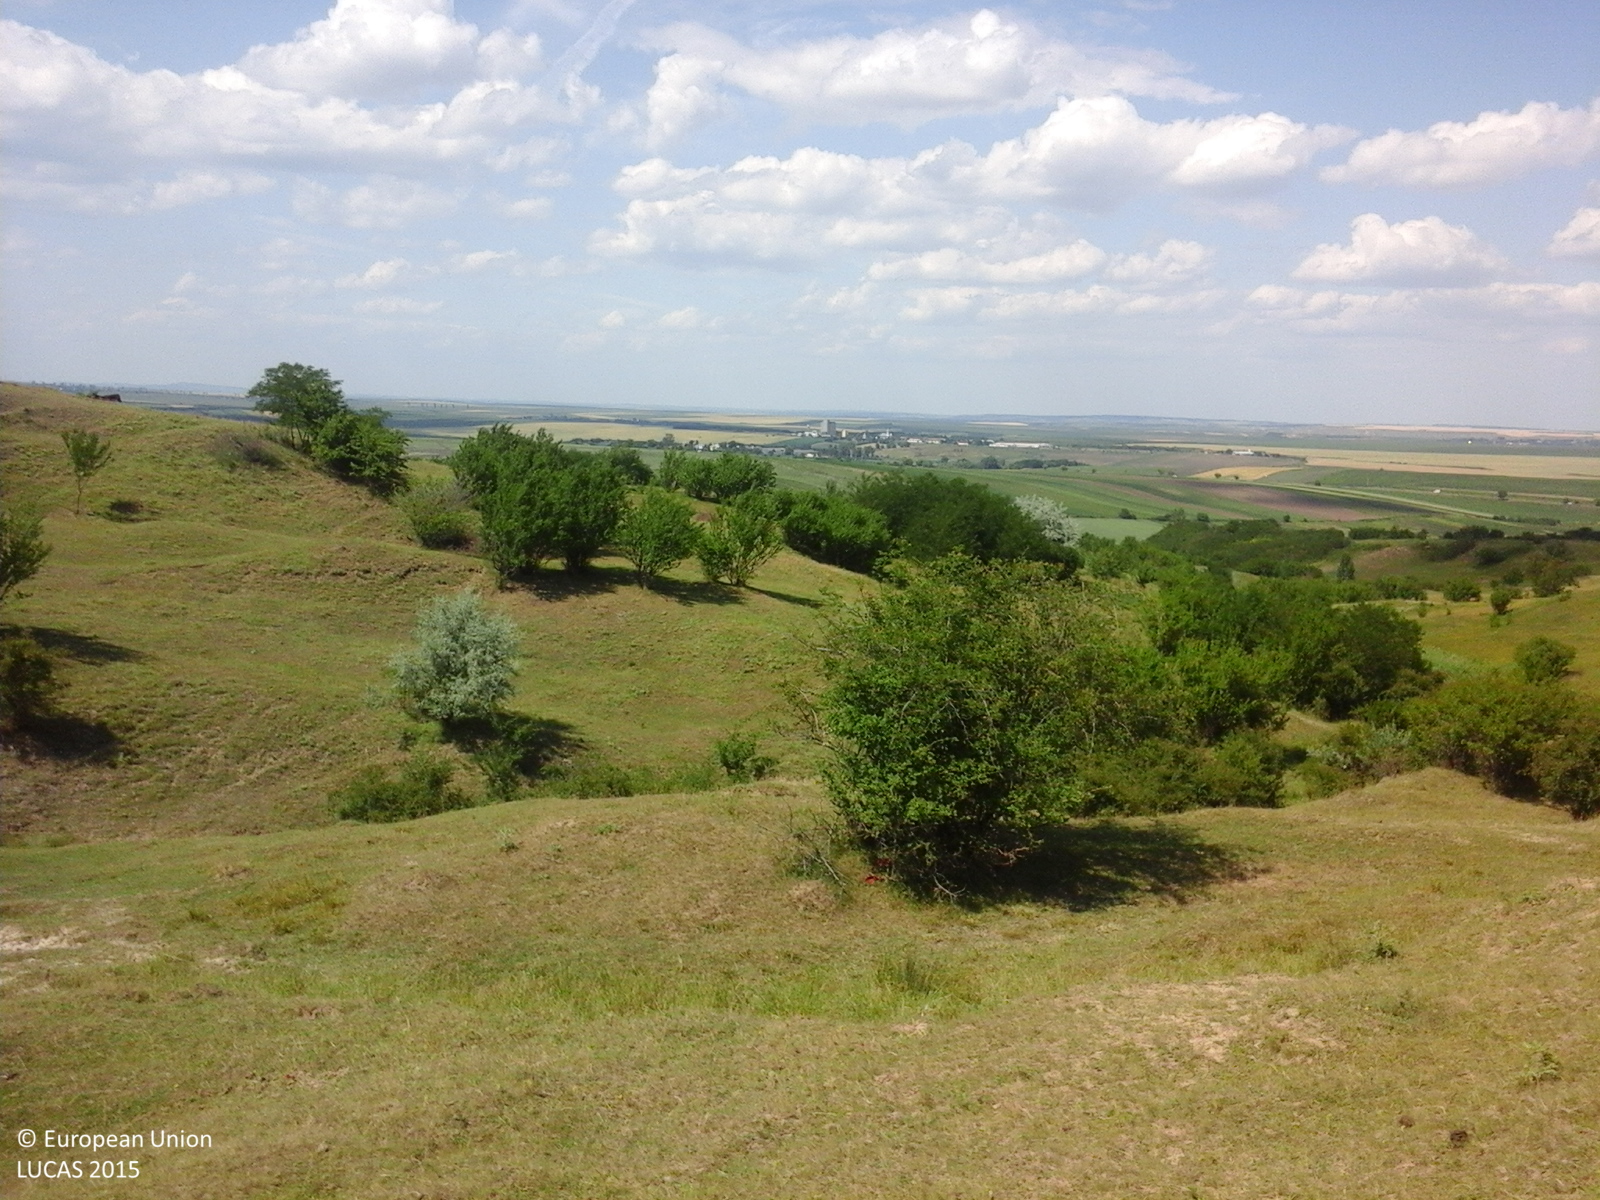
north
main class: Grassland
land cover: Grassland without tree/shrub cover
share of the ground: > 75 %
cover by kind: herbaceous plants 100 %
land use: Agriculture (excluding fallow land and kitchen gardens)
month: June
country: RO
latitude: 47.7955
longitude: 26.4980
